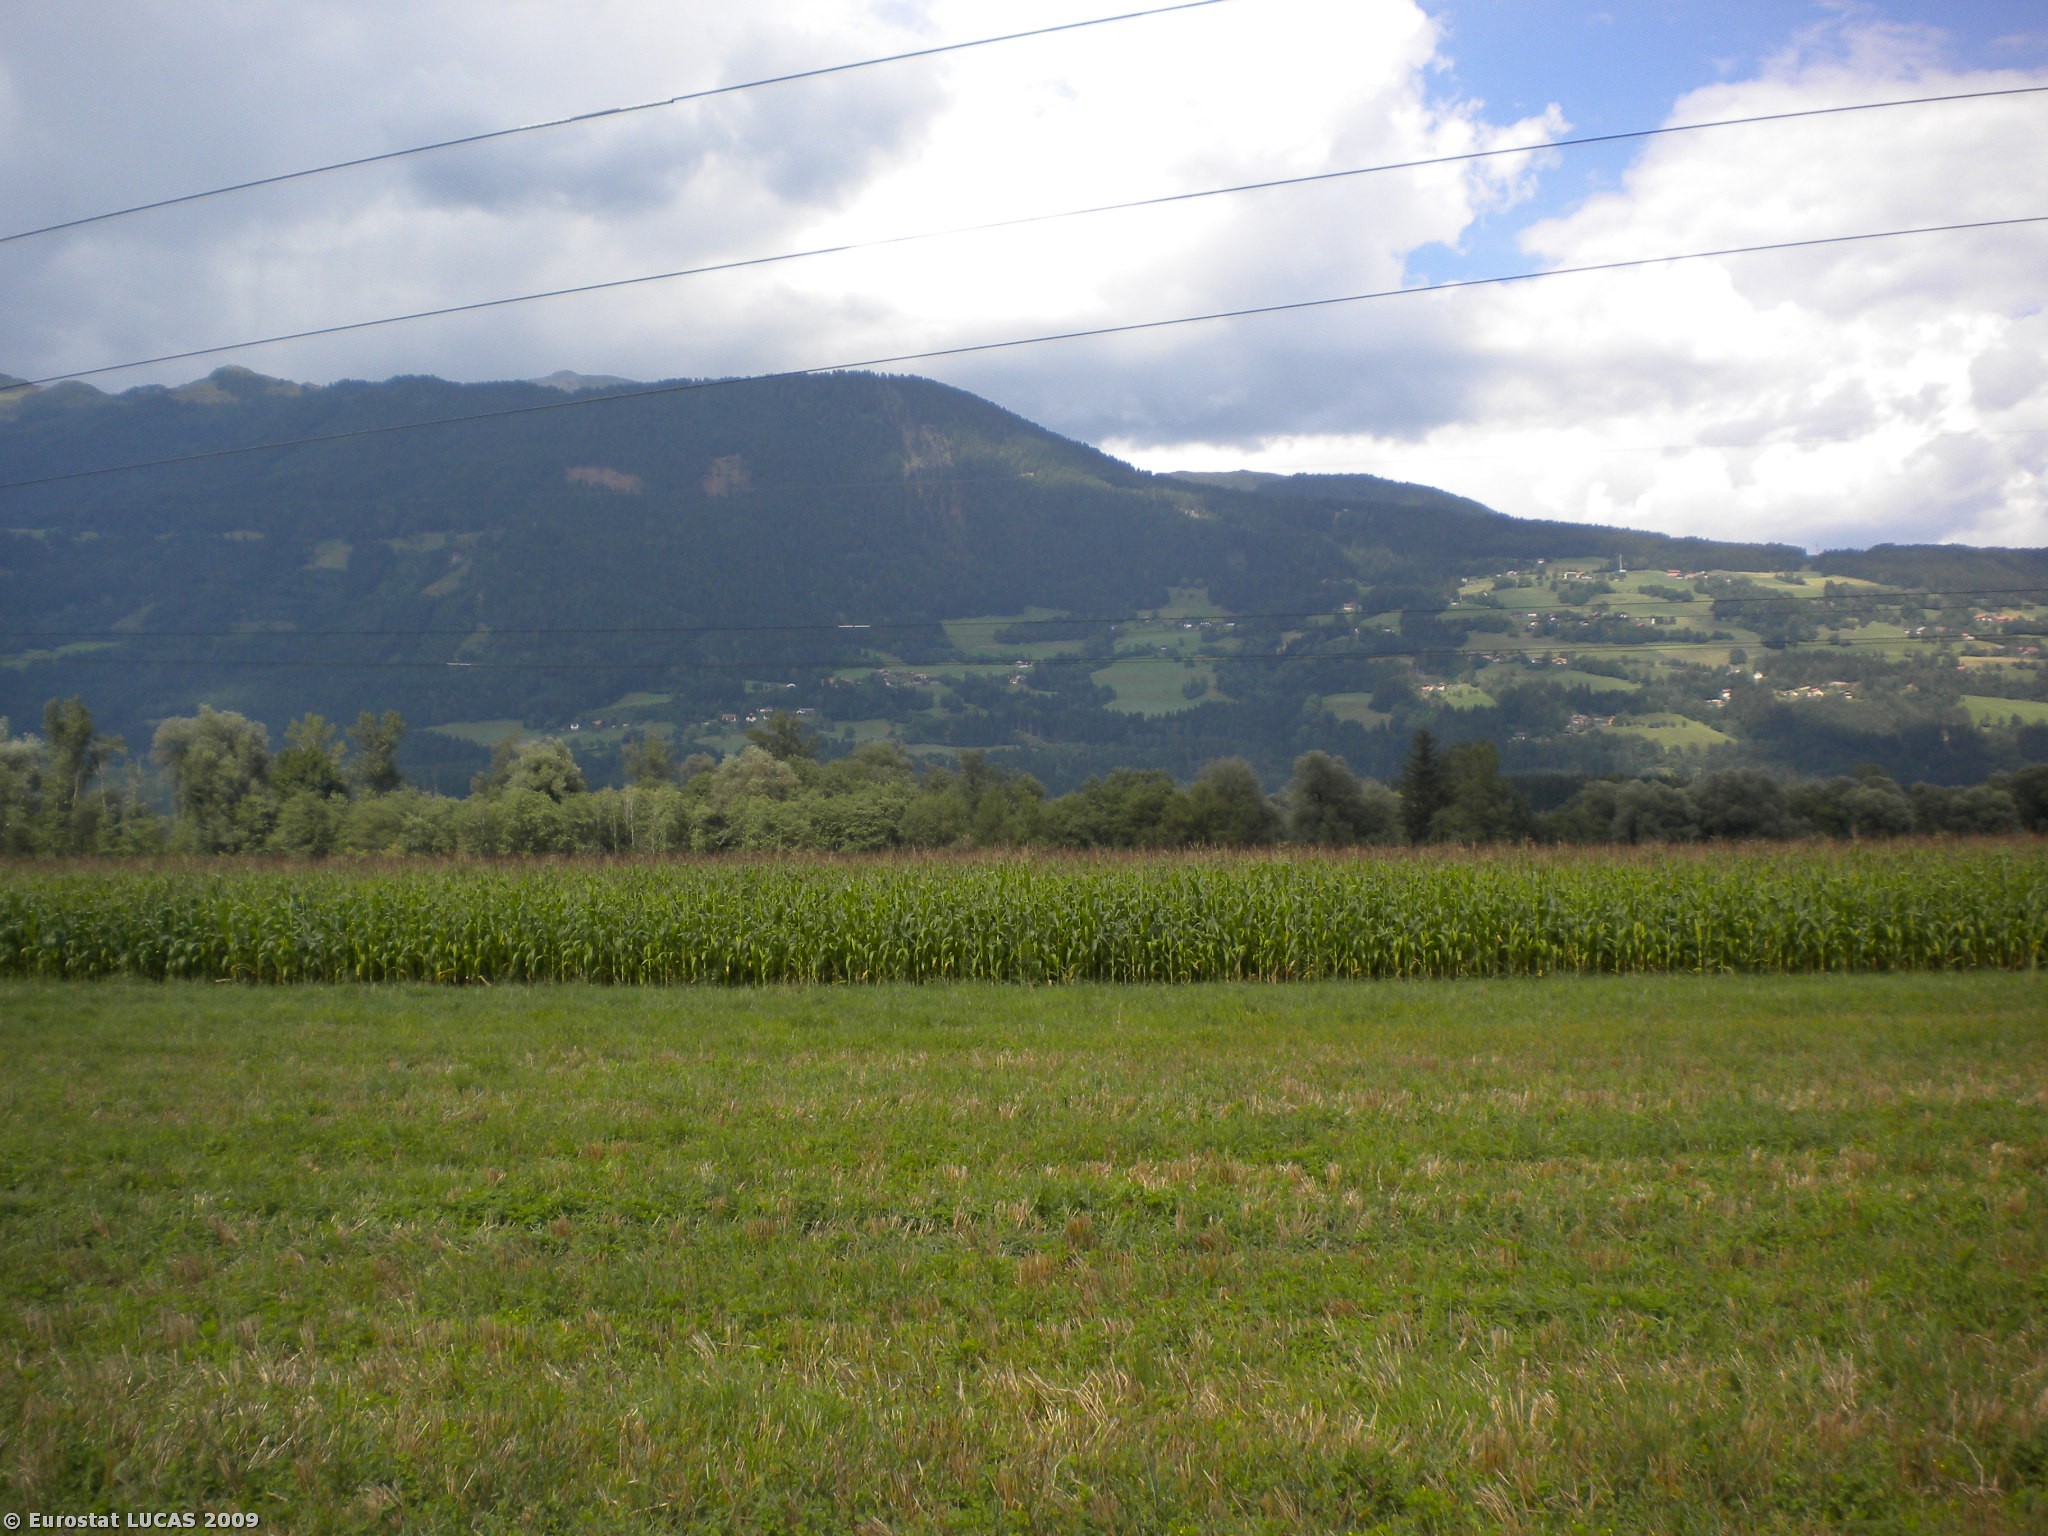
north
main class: Grassland
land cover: Grassland without tree/shrub cover
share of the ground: > 75 %
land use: Agriculture (excluding fallow land and kitchen gardens)
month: August
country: AT
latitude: 46.8193
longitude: 13.4184
